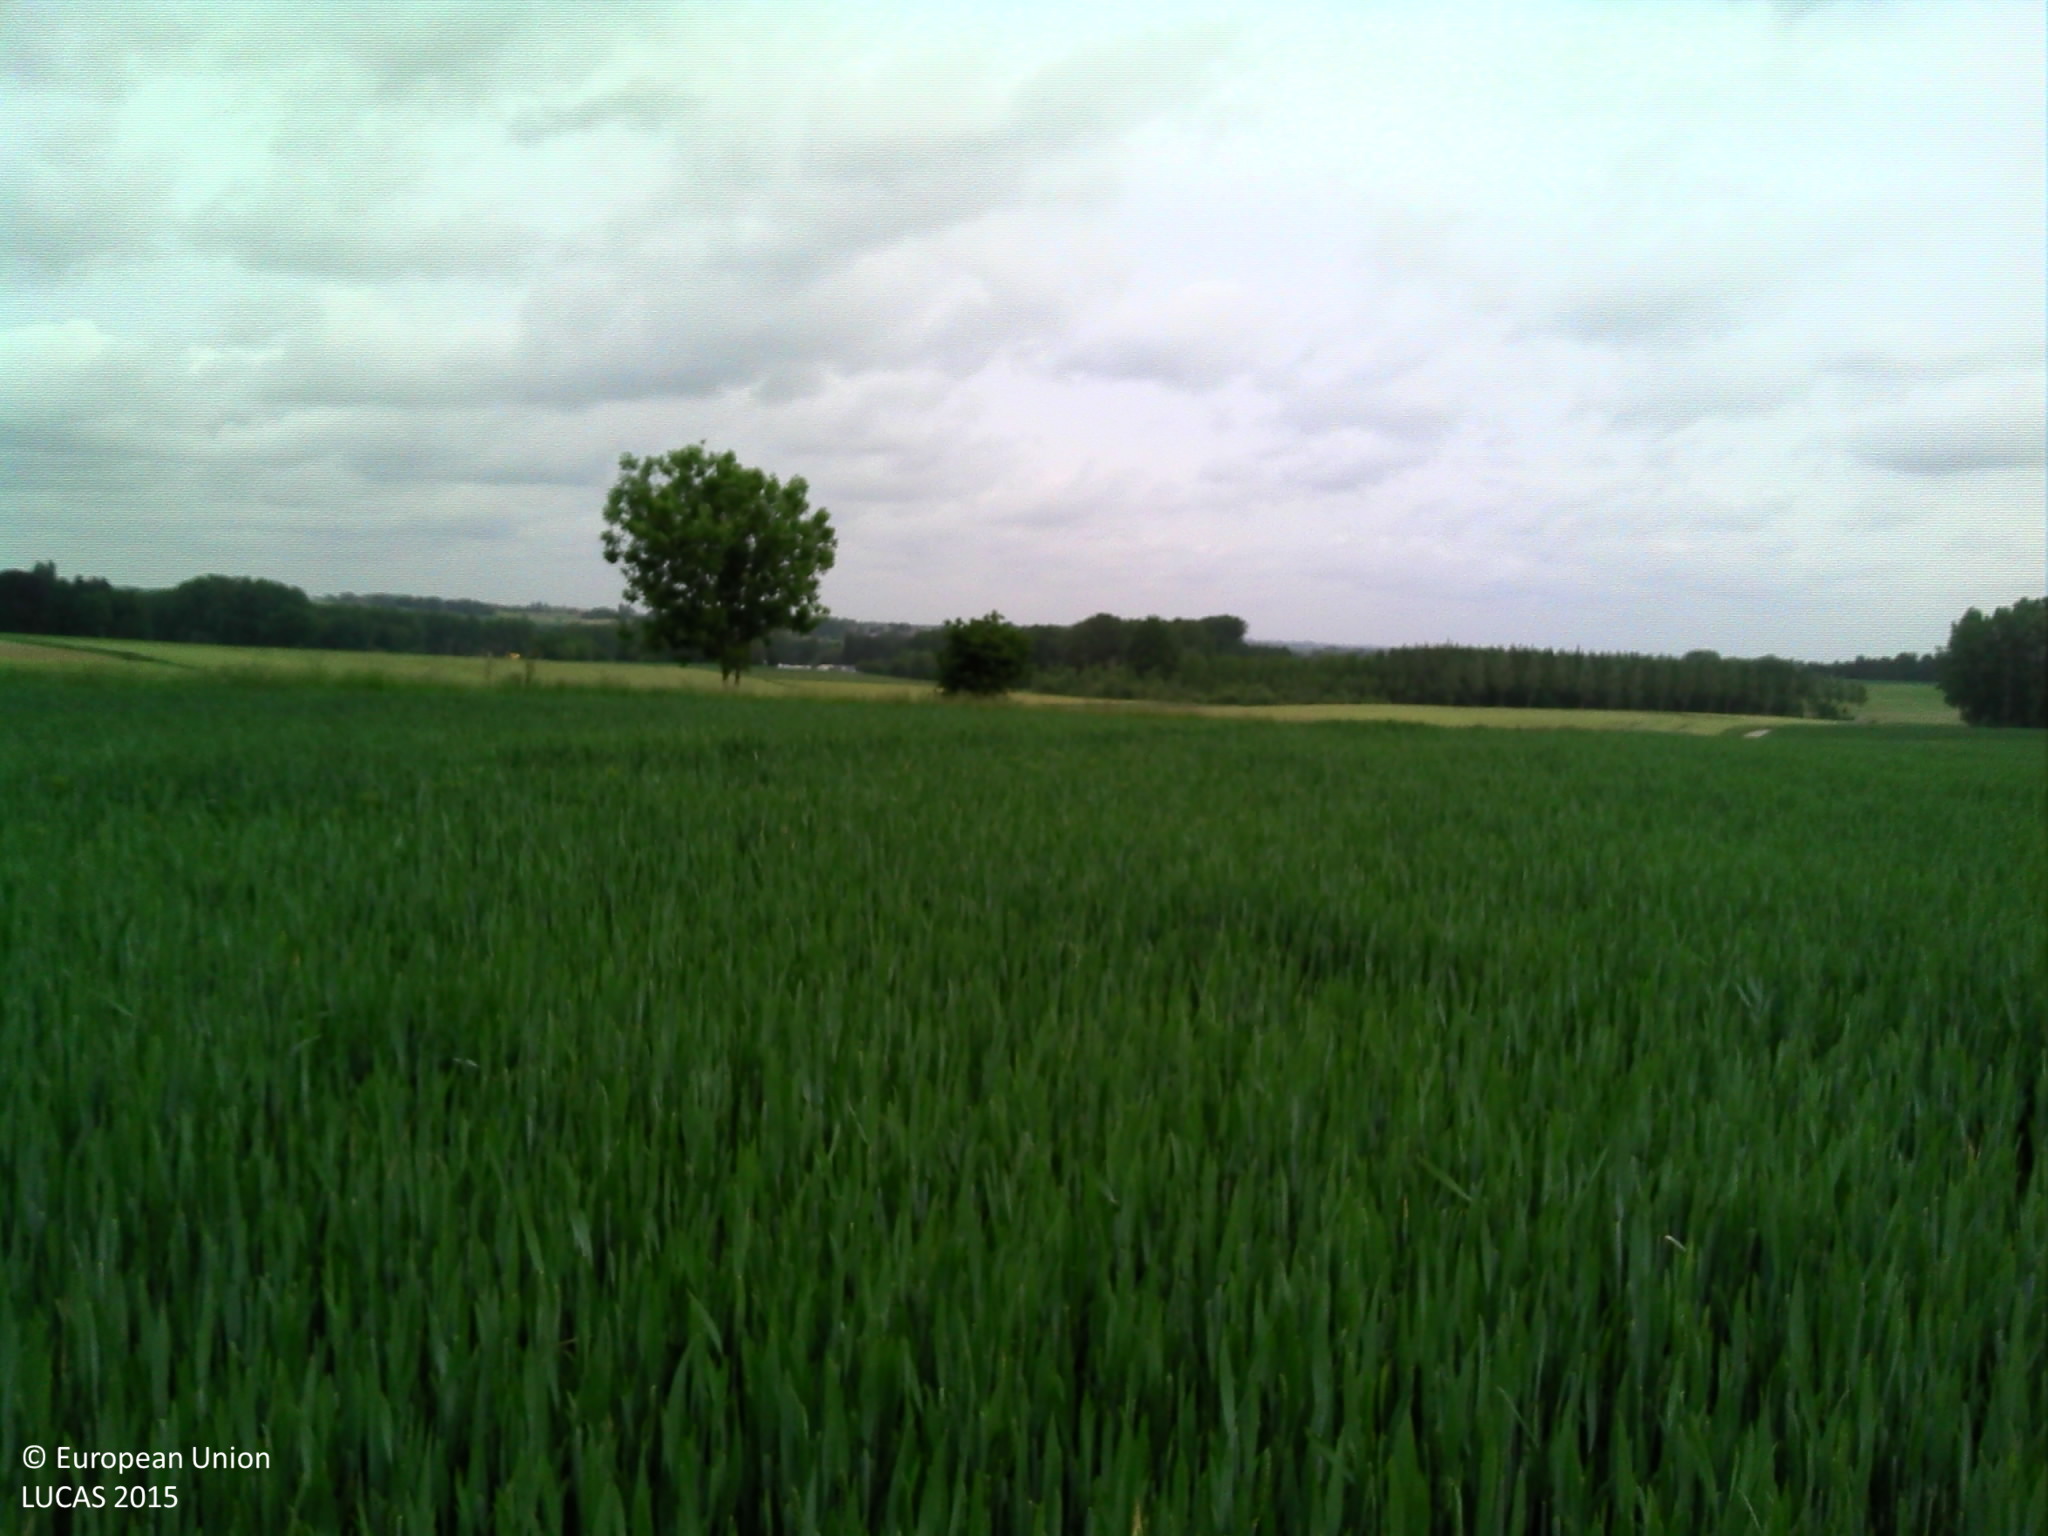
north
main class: Cropland
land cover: Common wheat
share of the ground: > 75 %
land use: Agriculture (excluding fallow land and kitchen gardens)
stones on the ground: < 10 %
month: May
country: BE
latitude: 50.6989
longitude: 4.8574
